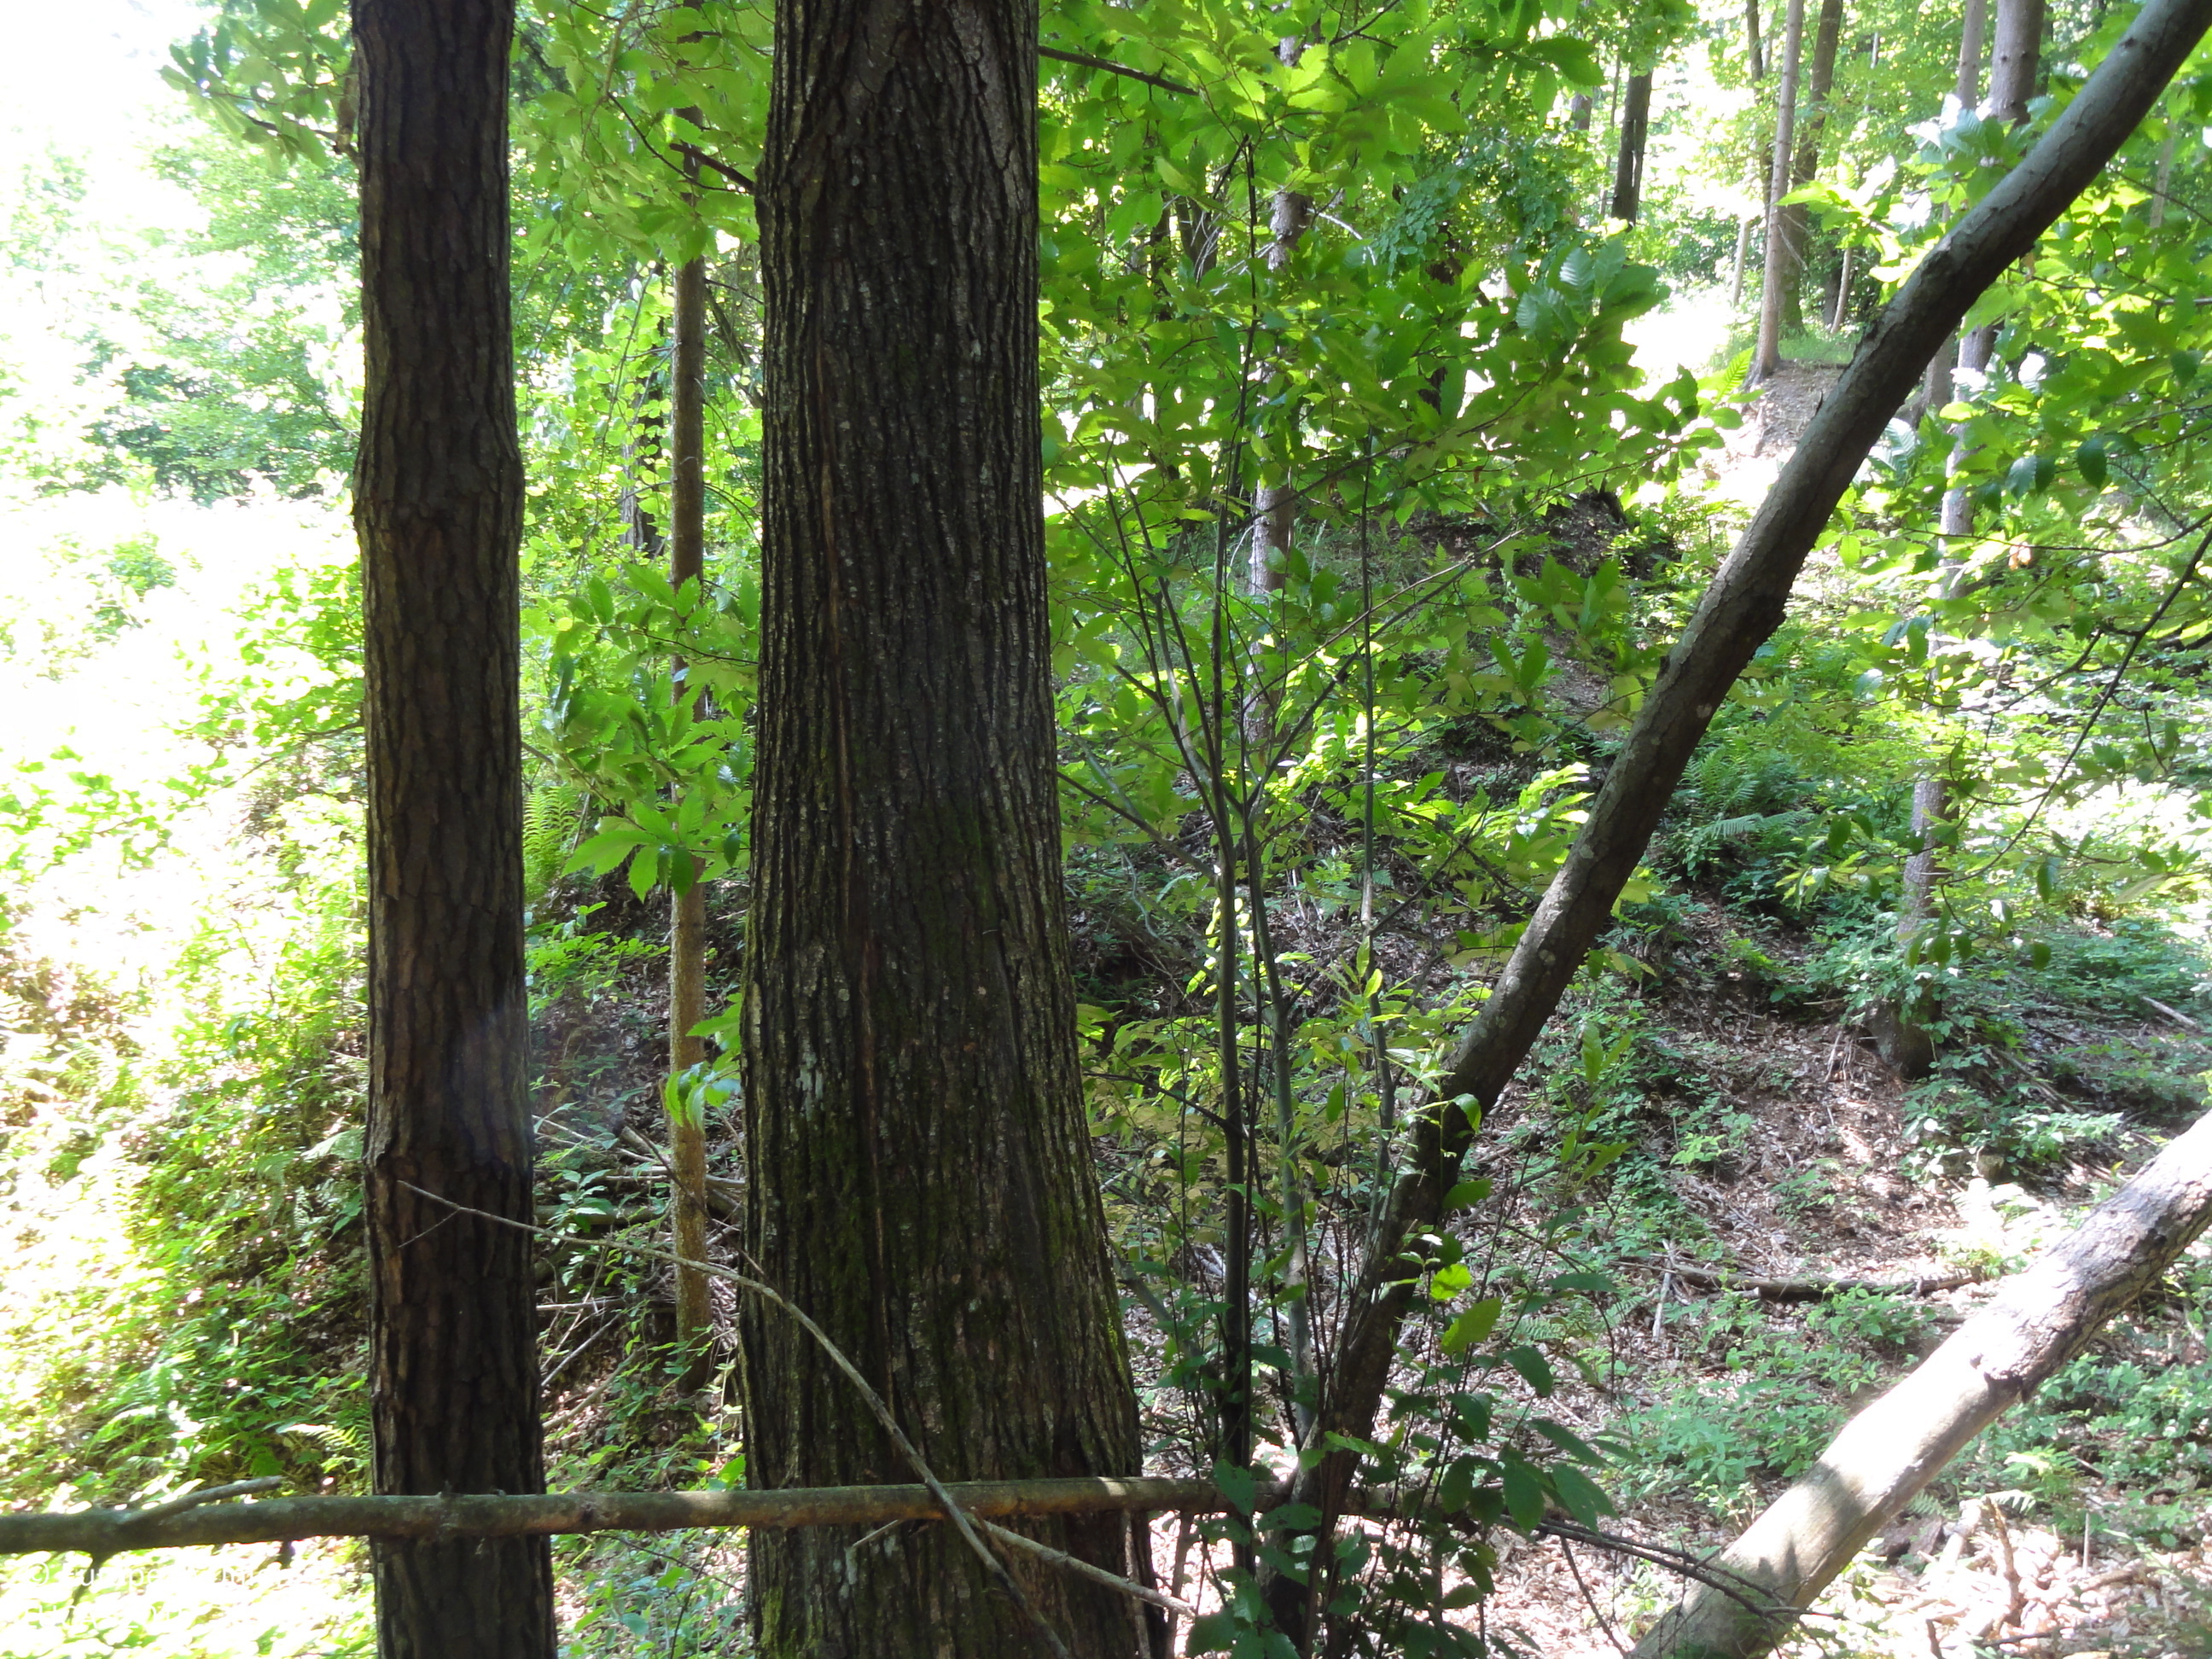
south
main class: Woodland
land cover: Other mixed woodland
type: mesophytic deciduous forest
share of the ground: > 75 %
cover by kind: coniferous forest trees 60 %, broadleaved forest trees 40 %
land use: Forestry
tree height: > 5 m
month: June
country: SI
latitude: 46.8573
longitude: 16.2052
